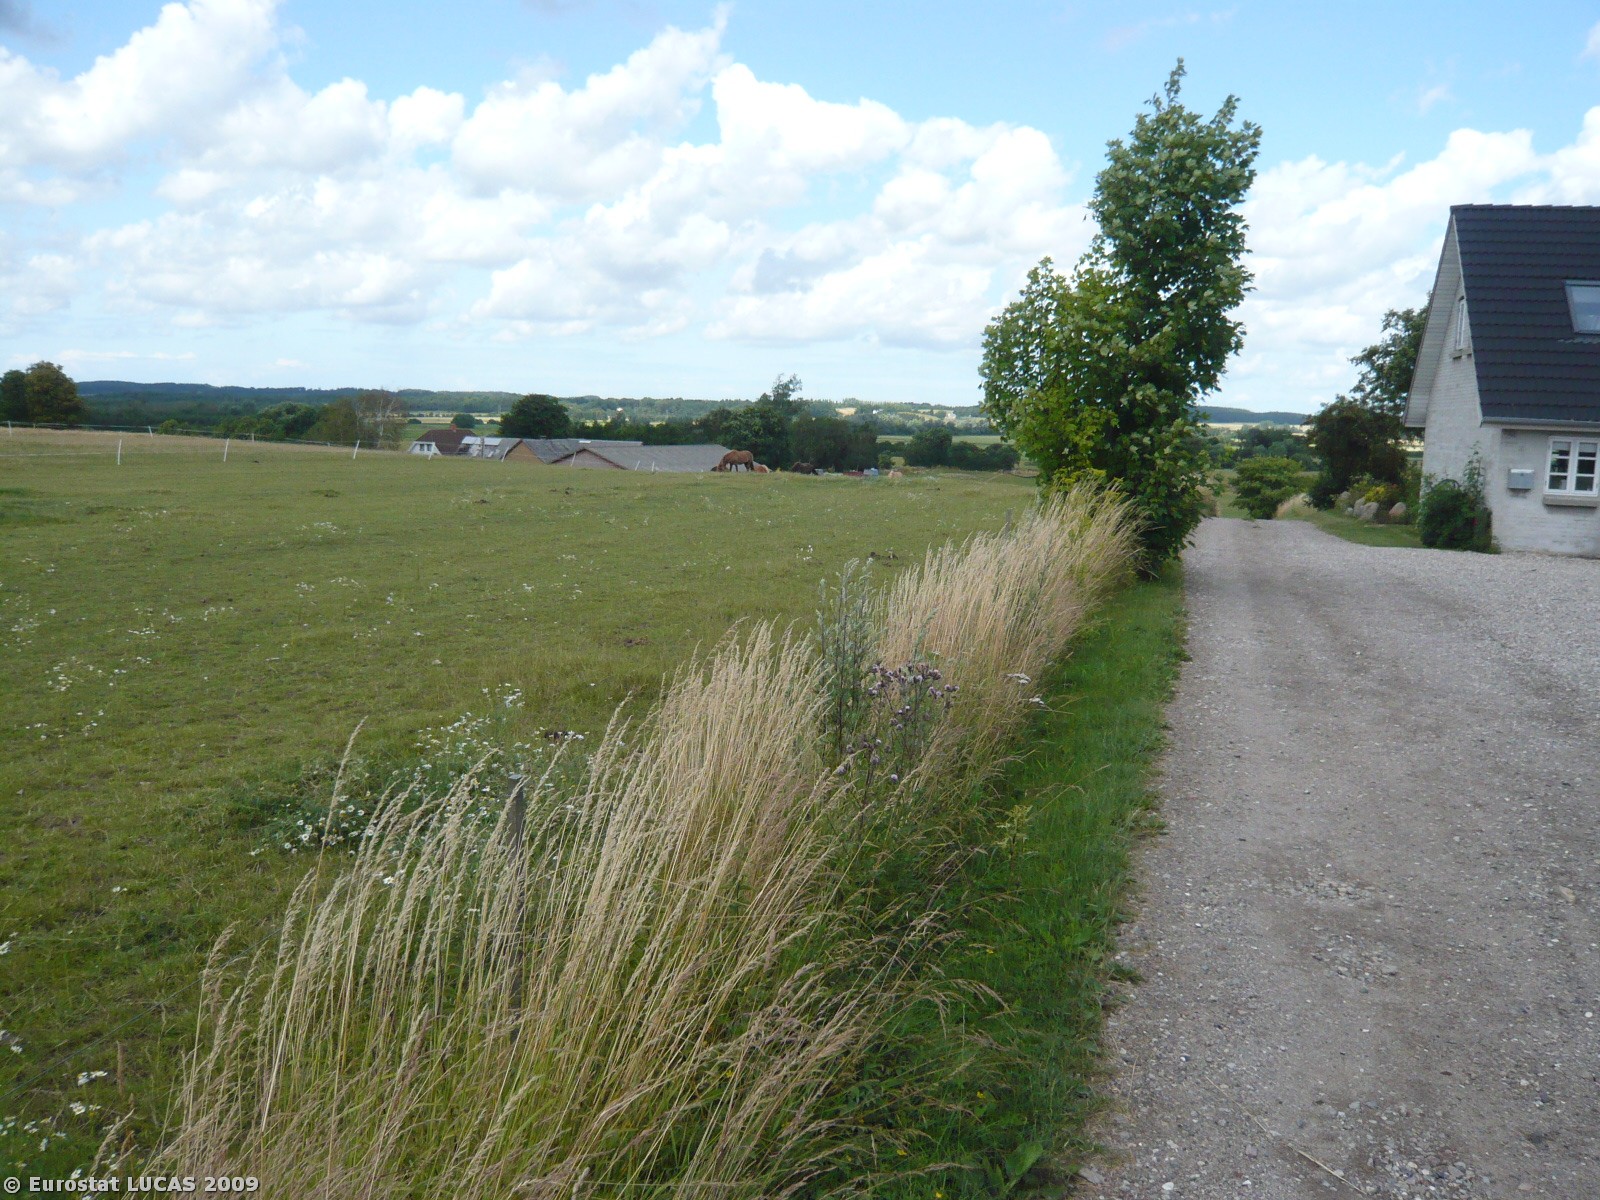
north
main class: Grassland
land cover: Grassland without tree/shrub cover
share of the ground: > 75 %
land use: Agriculture (excluding fallow land and kitchen gardens)
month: July
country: DK
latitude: 55.5684
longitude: 11.4418
